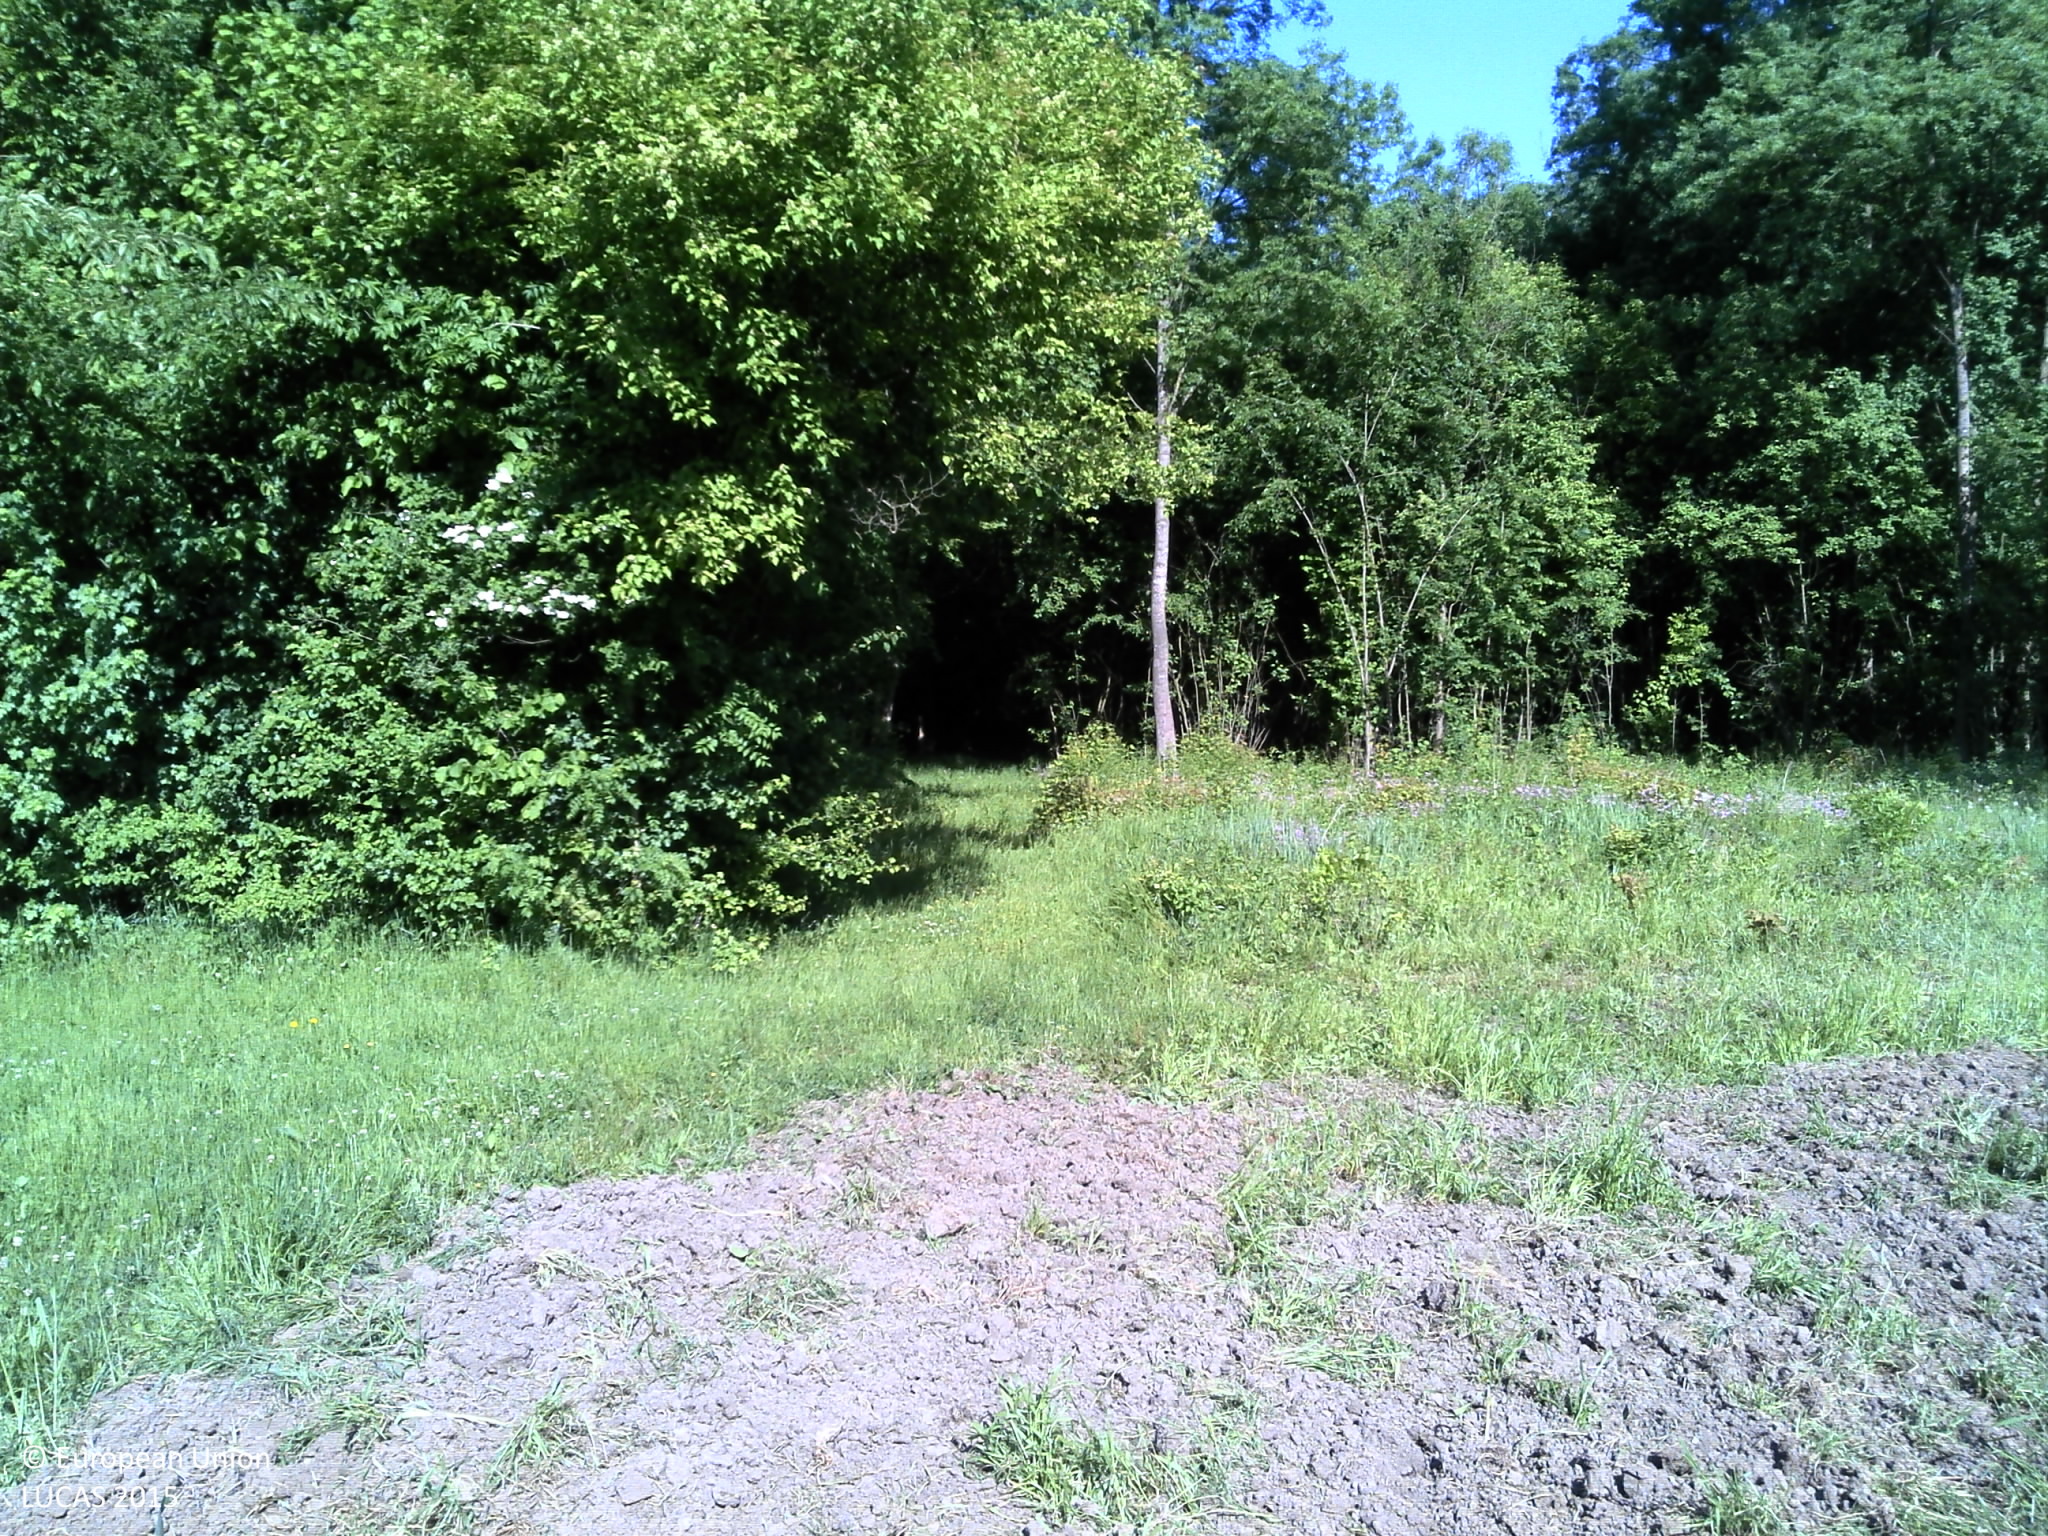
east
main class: Grassland
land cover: Spontaneously vegetated surfaces
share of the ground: < 10 %
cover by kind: unconsolidated bare surface 90 %, herbaceous plants 10 %
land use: Fallow land
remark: Harvested field
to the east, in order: Spontaneously vegetated surfaces; Grass margins; Broadleaved woodland
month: May
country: HR
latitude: 45.1522
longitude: 18.1563
